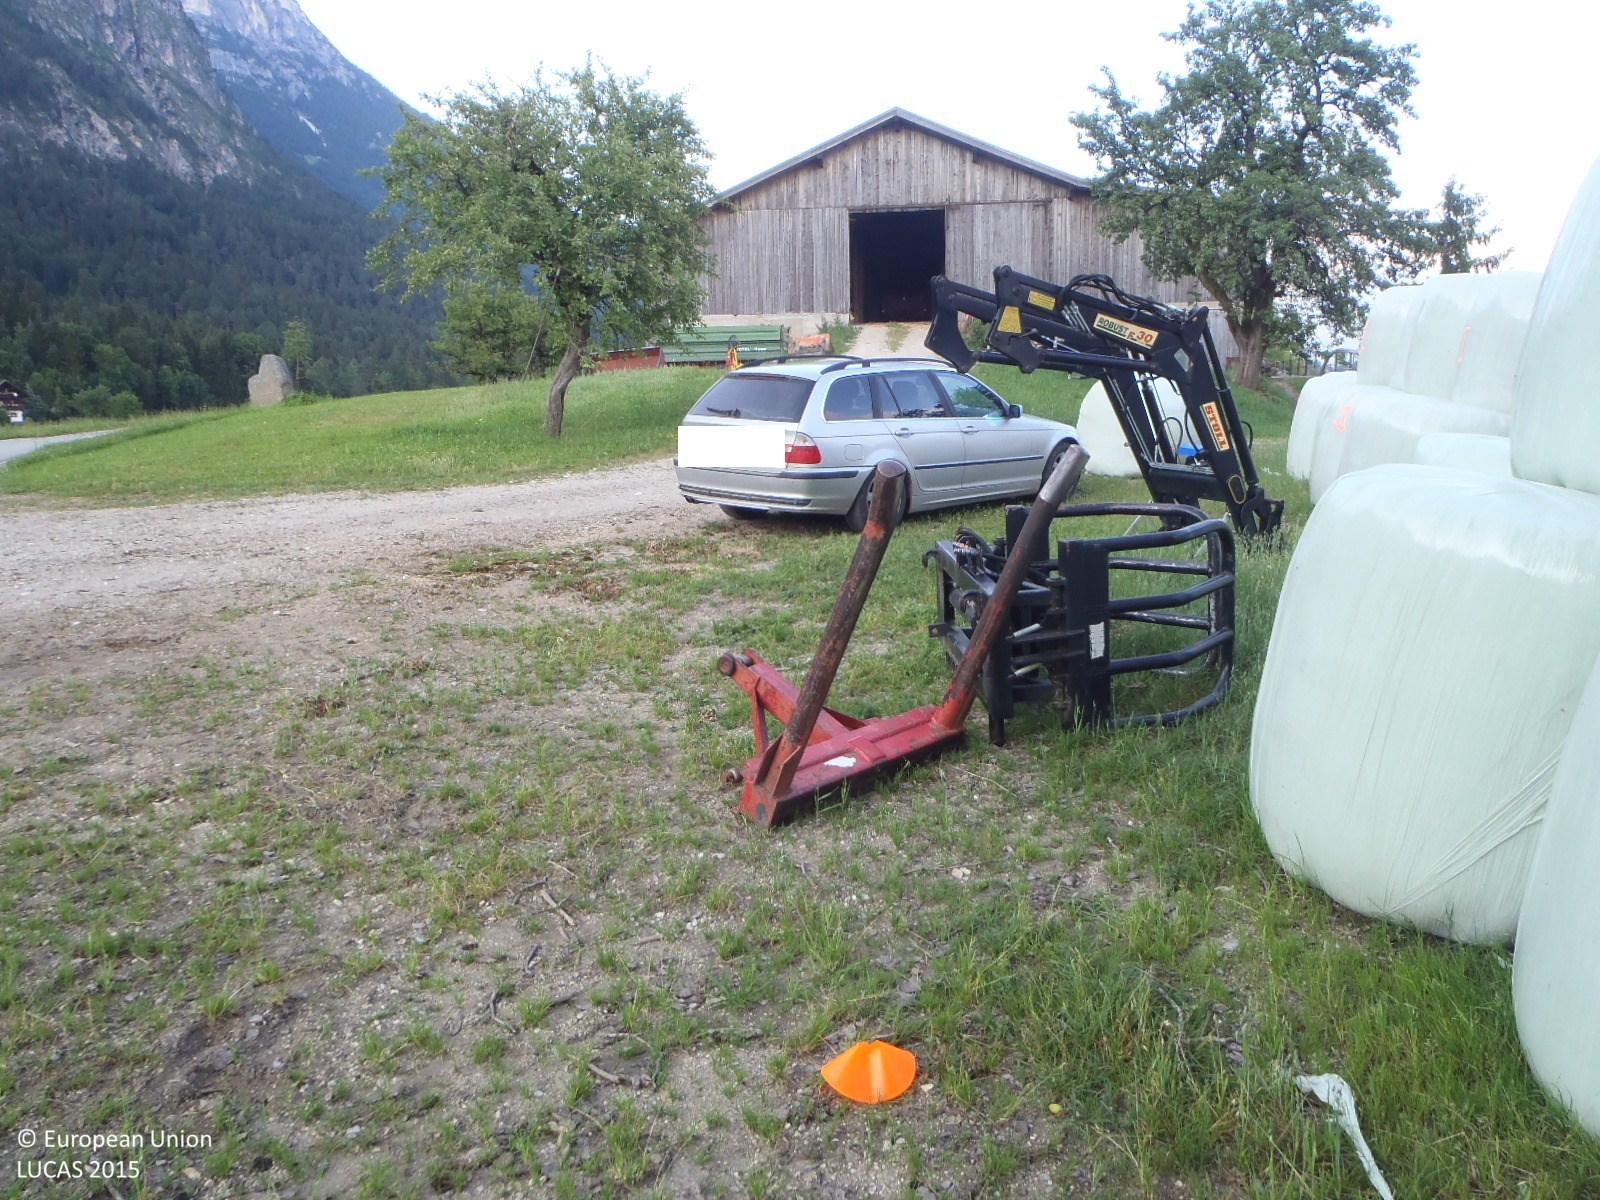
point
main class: Grassland
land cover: Grassland without tree/shrub cover
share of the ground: 50 - 75 %
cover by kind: herbaceous plants 60 %, unconsolidated bare surface 40 %
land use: Agriculture (excluding fallow land and kitchen gardens)
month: July
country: AT
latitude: 47.5207
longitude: 12.0304
